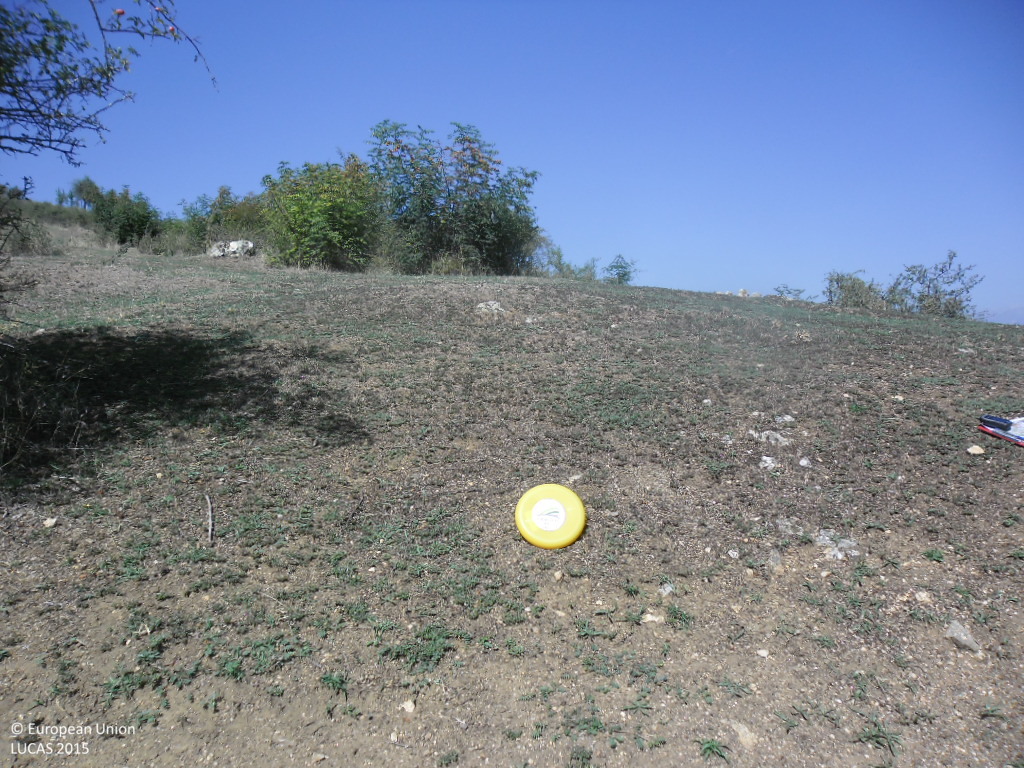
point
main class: Grassland
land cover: Grassland with sparse tree/shrub cover
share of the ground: > 75 %
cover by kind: herbaceous plants 90 %, broadleaved forest trees 5 %, shrubs 5 %
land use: Agriculture (excluding fallow land and kitchen gardens)
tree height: < 5 m
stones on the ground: < 10 %
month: September
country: BG
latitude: 41.4809
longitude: 23.1569
